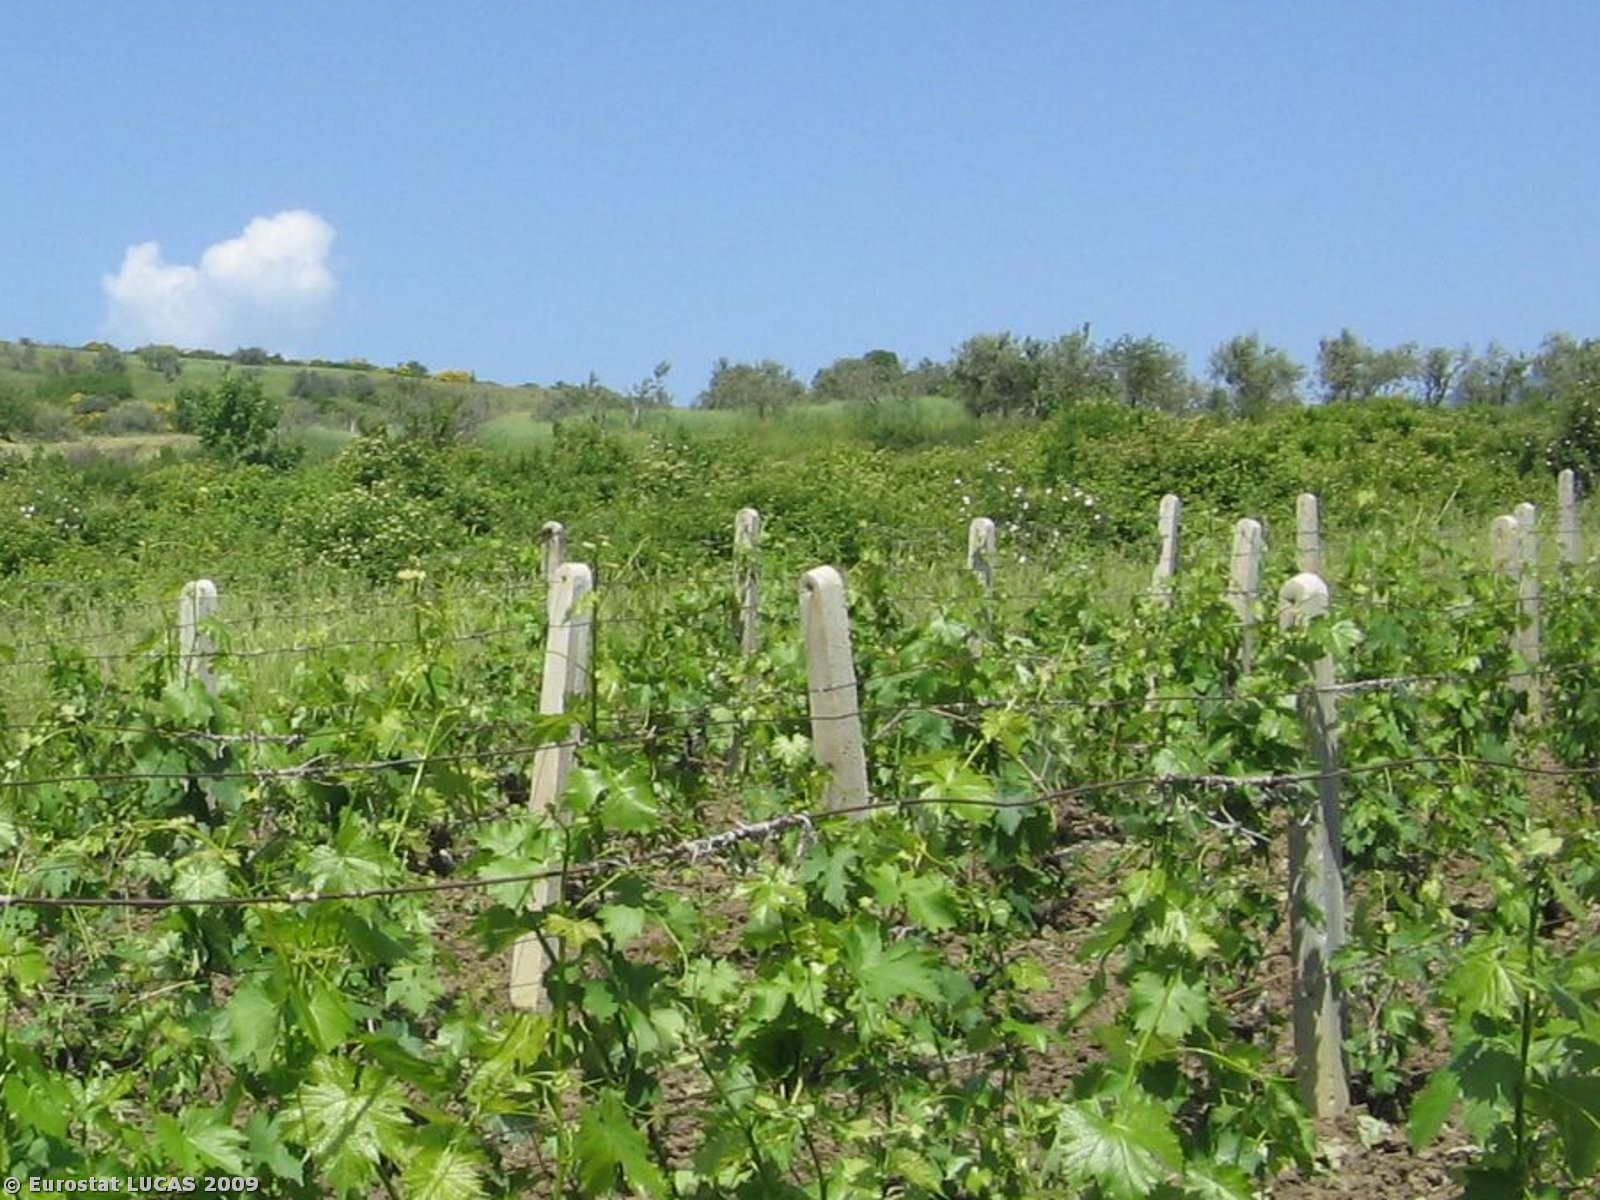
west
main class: Cropland
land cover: Vineyards
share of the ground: 25 - 50 %
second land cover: Bare land
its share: > 75 %
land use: Agriculture (excluding fallow land and kitchen gardens)
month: May
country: IT
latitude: 41.7815
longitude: 14.3767
